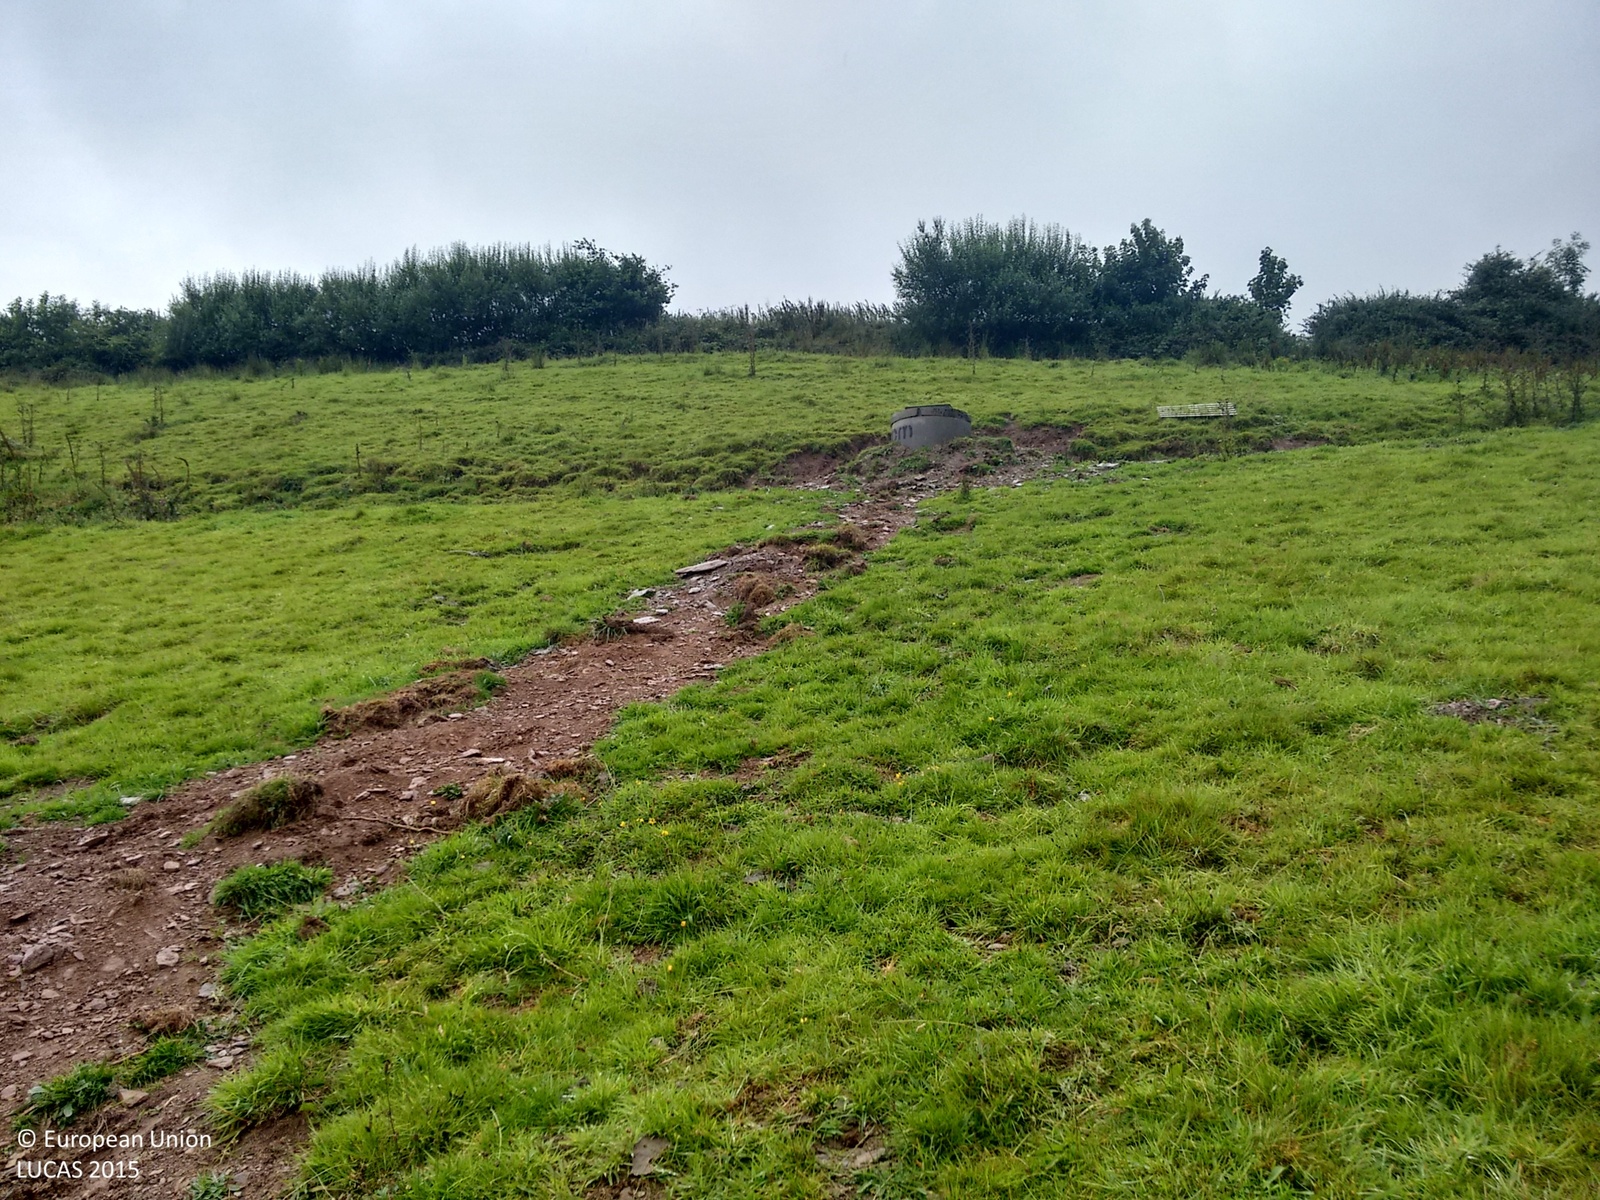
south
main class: Grassland
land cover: Grassland without tree/shrub cover
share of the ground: > 75 %
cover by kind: herbaceous plants 100 %
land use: Agriculture (excluding fallow land and kitchen gardens)
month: August
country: GB
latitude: 51.0854
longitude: -3.5474
